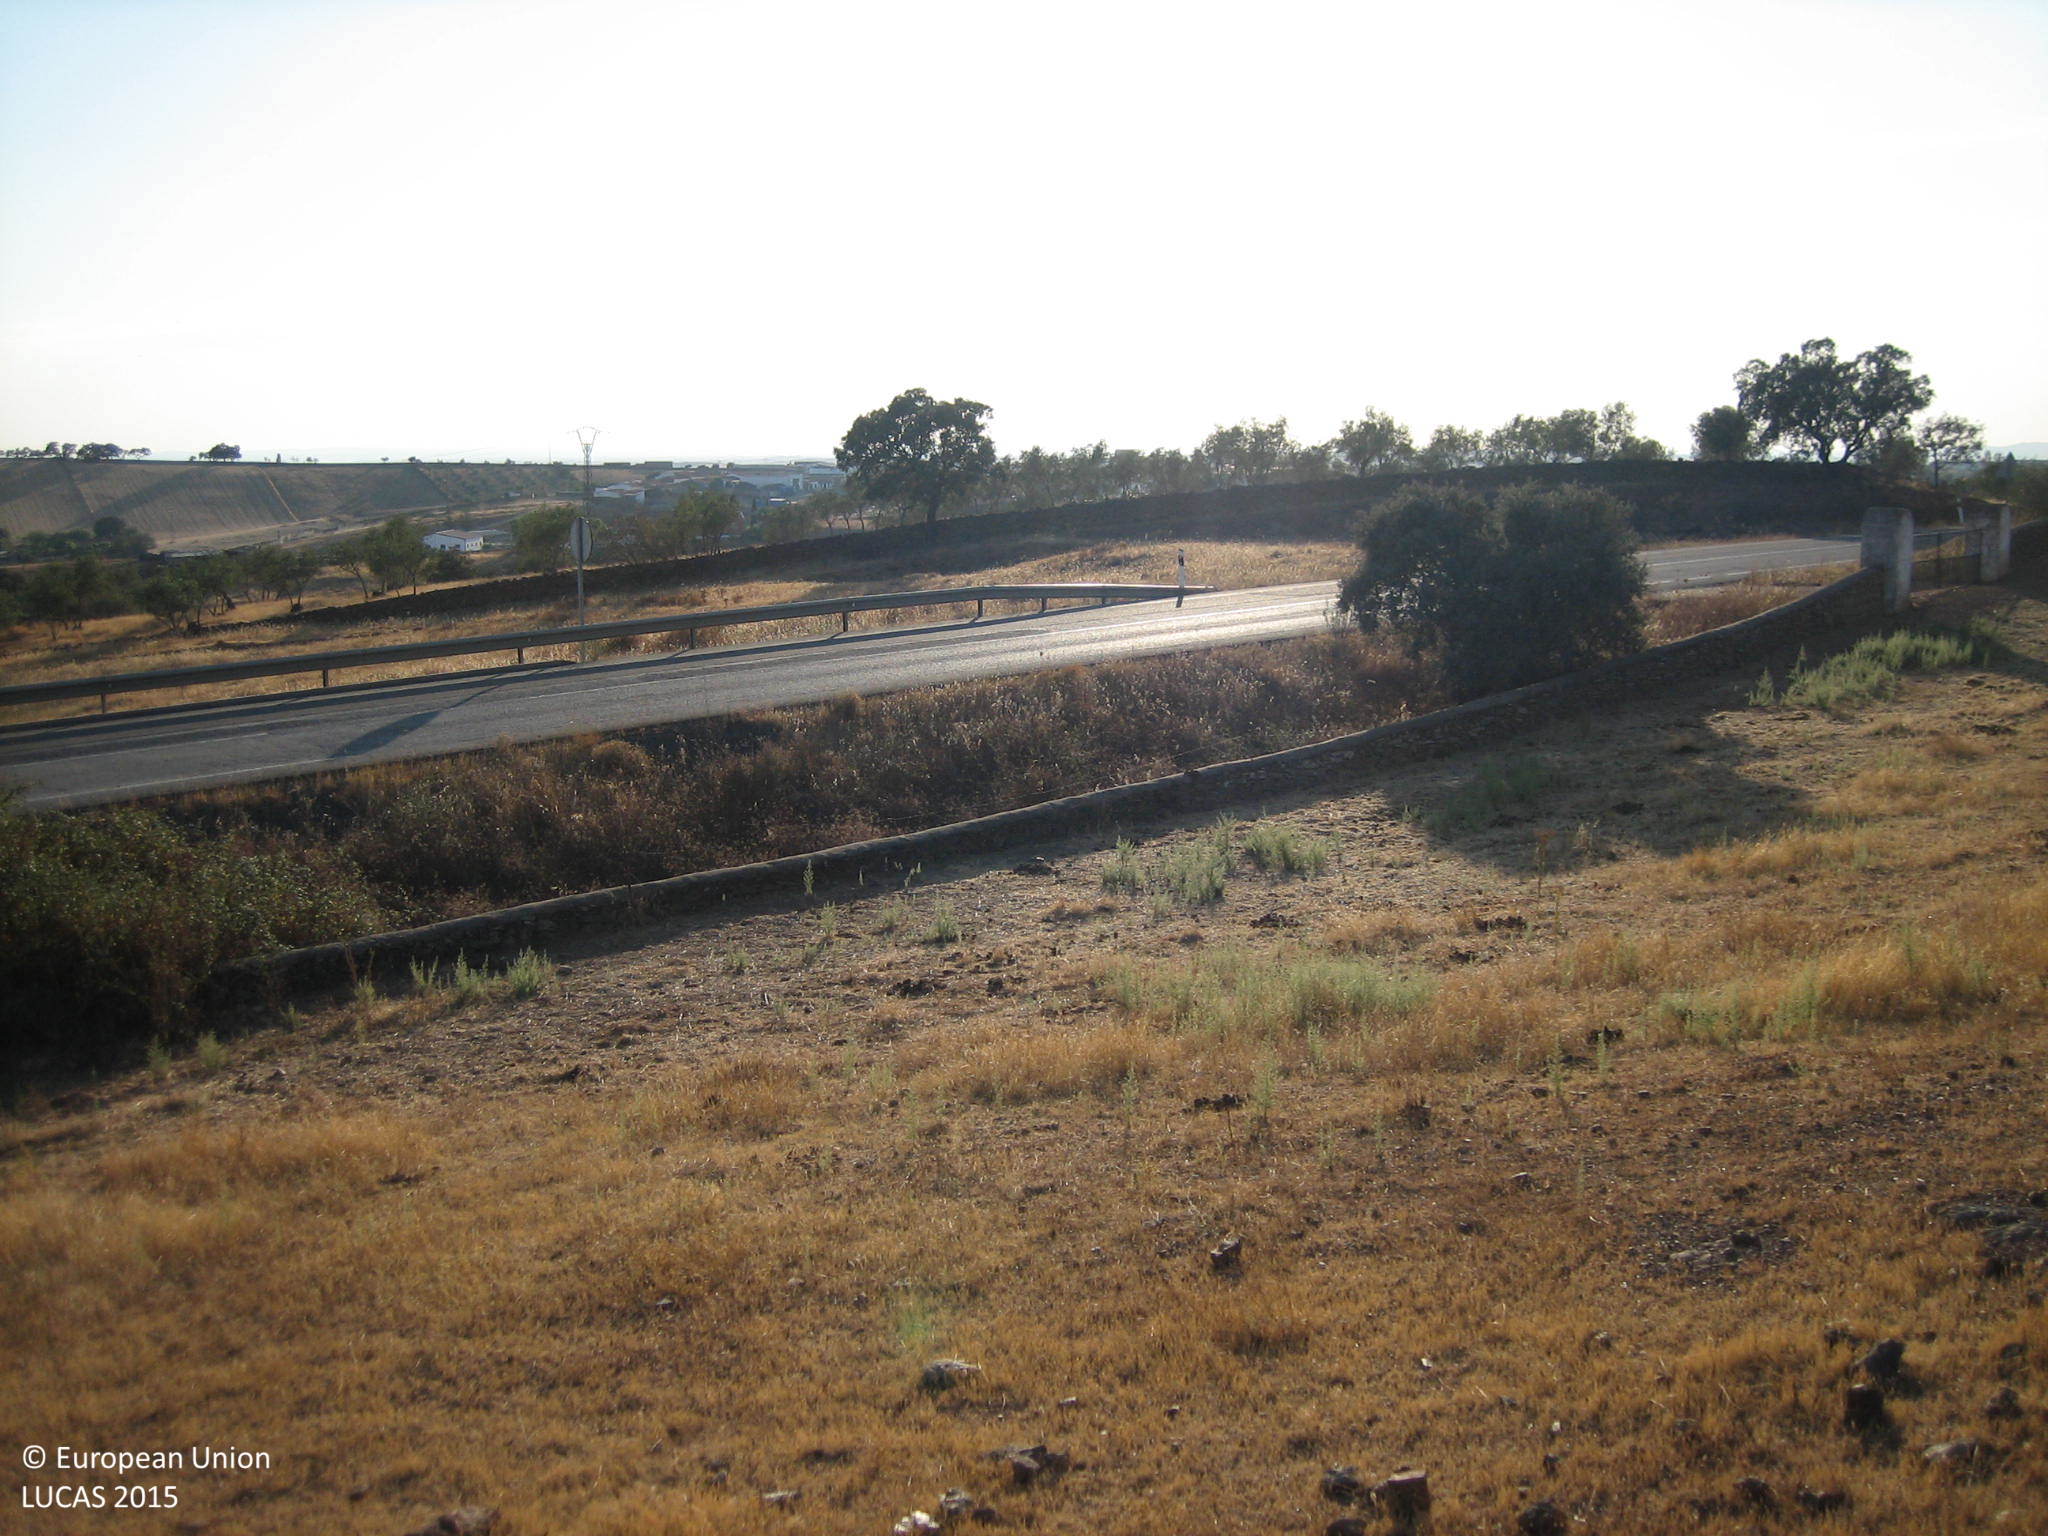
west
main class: Grassland
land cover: Grassland without tree/shrub cover
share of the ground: 50 - 75 %
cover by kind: herbaceous plants 70 %, unconsolidated bare surface 30 %
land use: Agriculture (excluding fallow land and kitchen gardens)
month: September
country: ES
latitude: 38.3746
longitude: -7.1540
